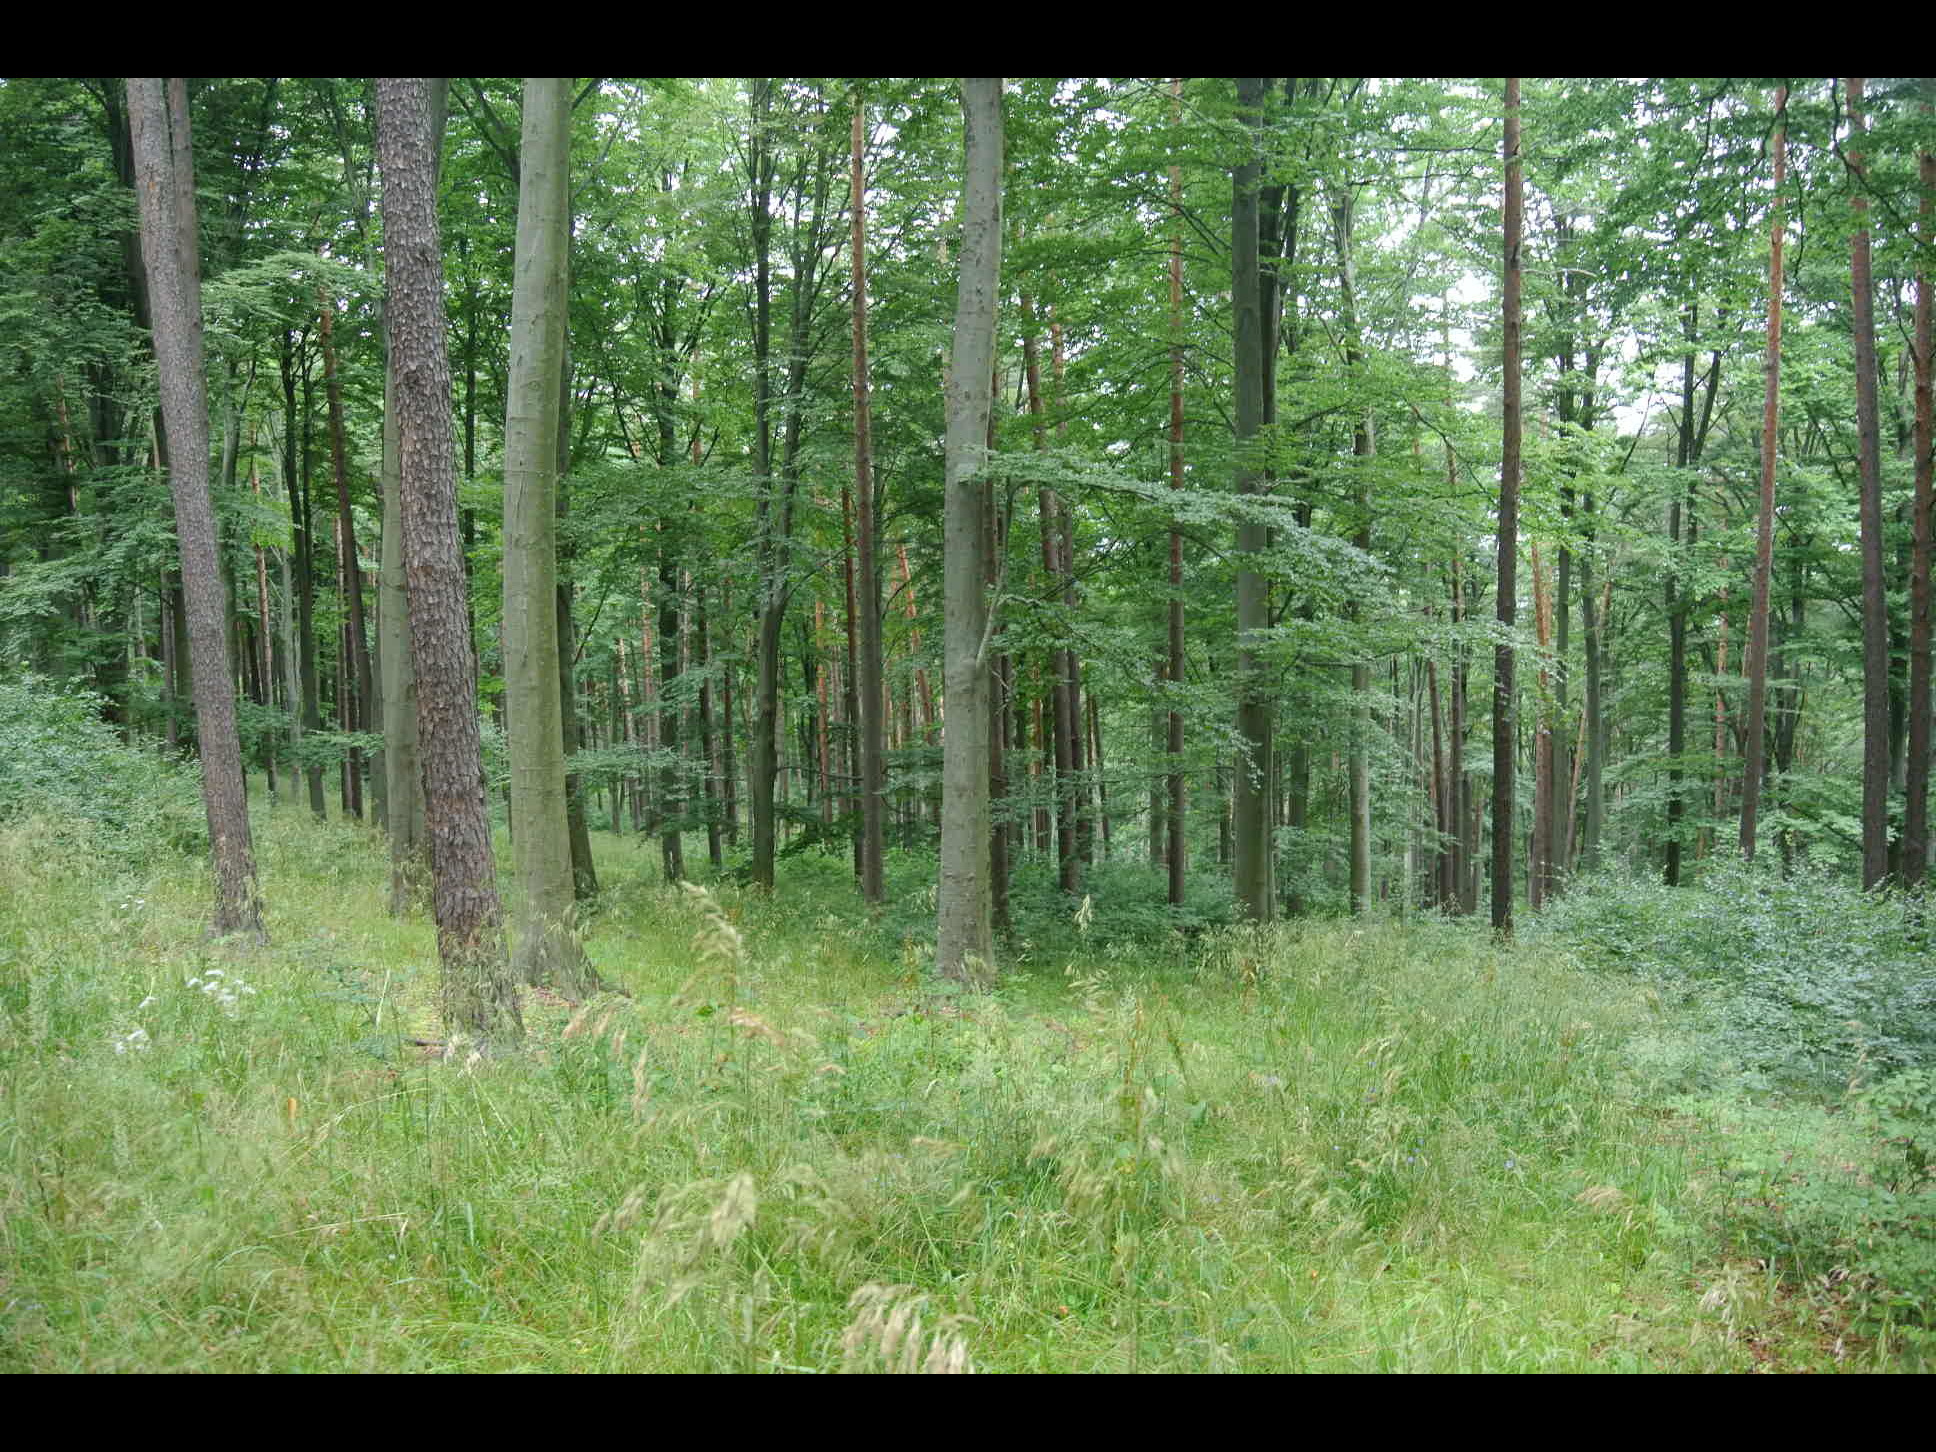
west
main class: Woodland
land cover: Pine dominated mixed woodland
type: alpine coniferous forest
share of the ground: > 75 %
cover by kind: broadleaved forest trees 45 %, coniferous forest trees 35 %, herbaceous plants 20 %
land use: Forestry
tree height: > 5 m
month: July
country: AT
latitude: 47.6400
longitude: 16.4062
